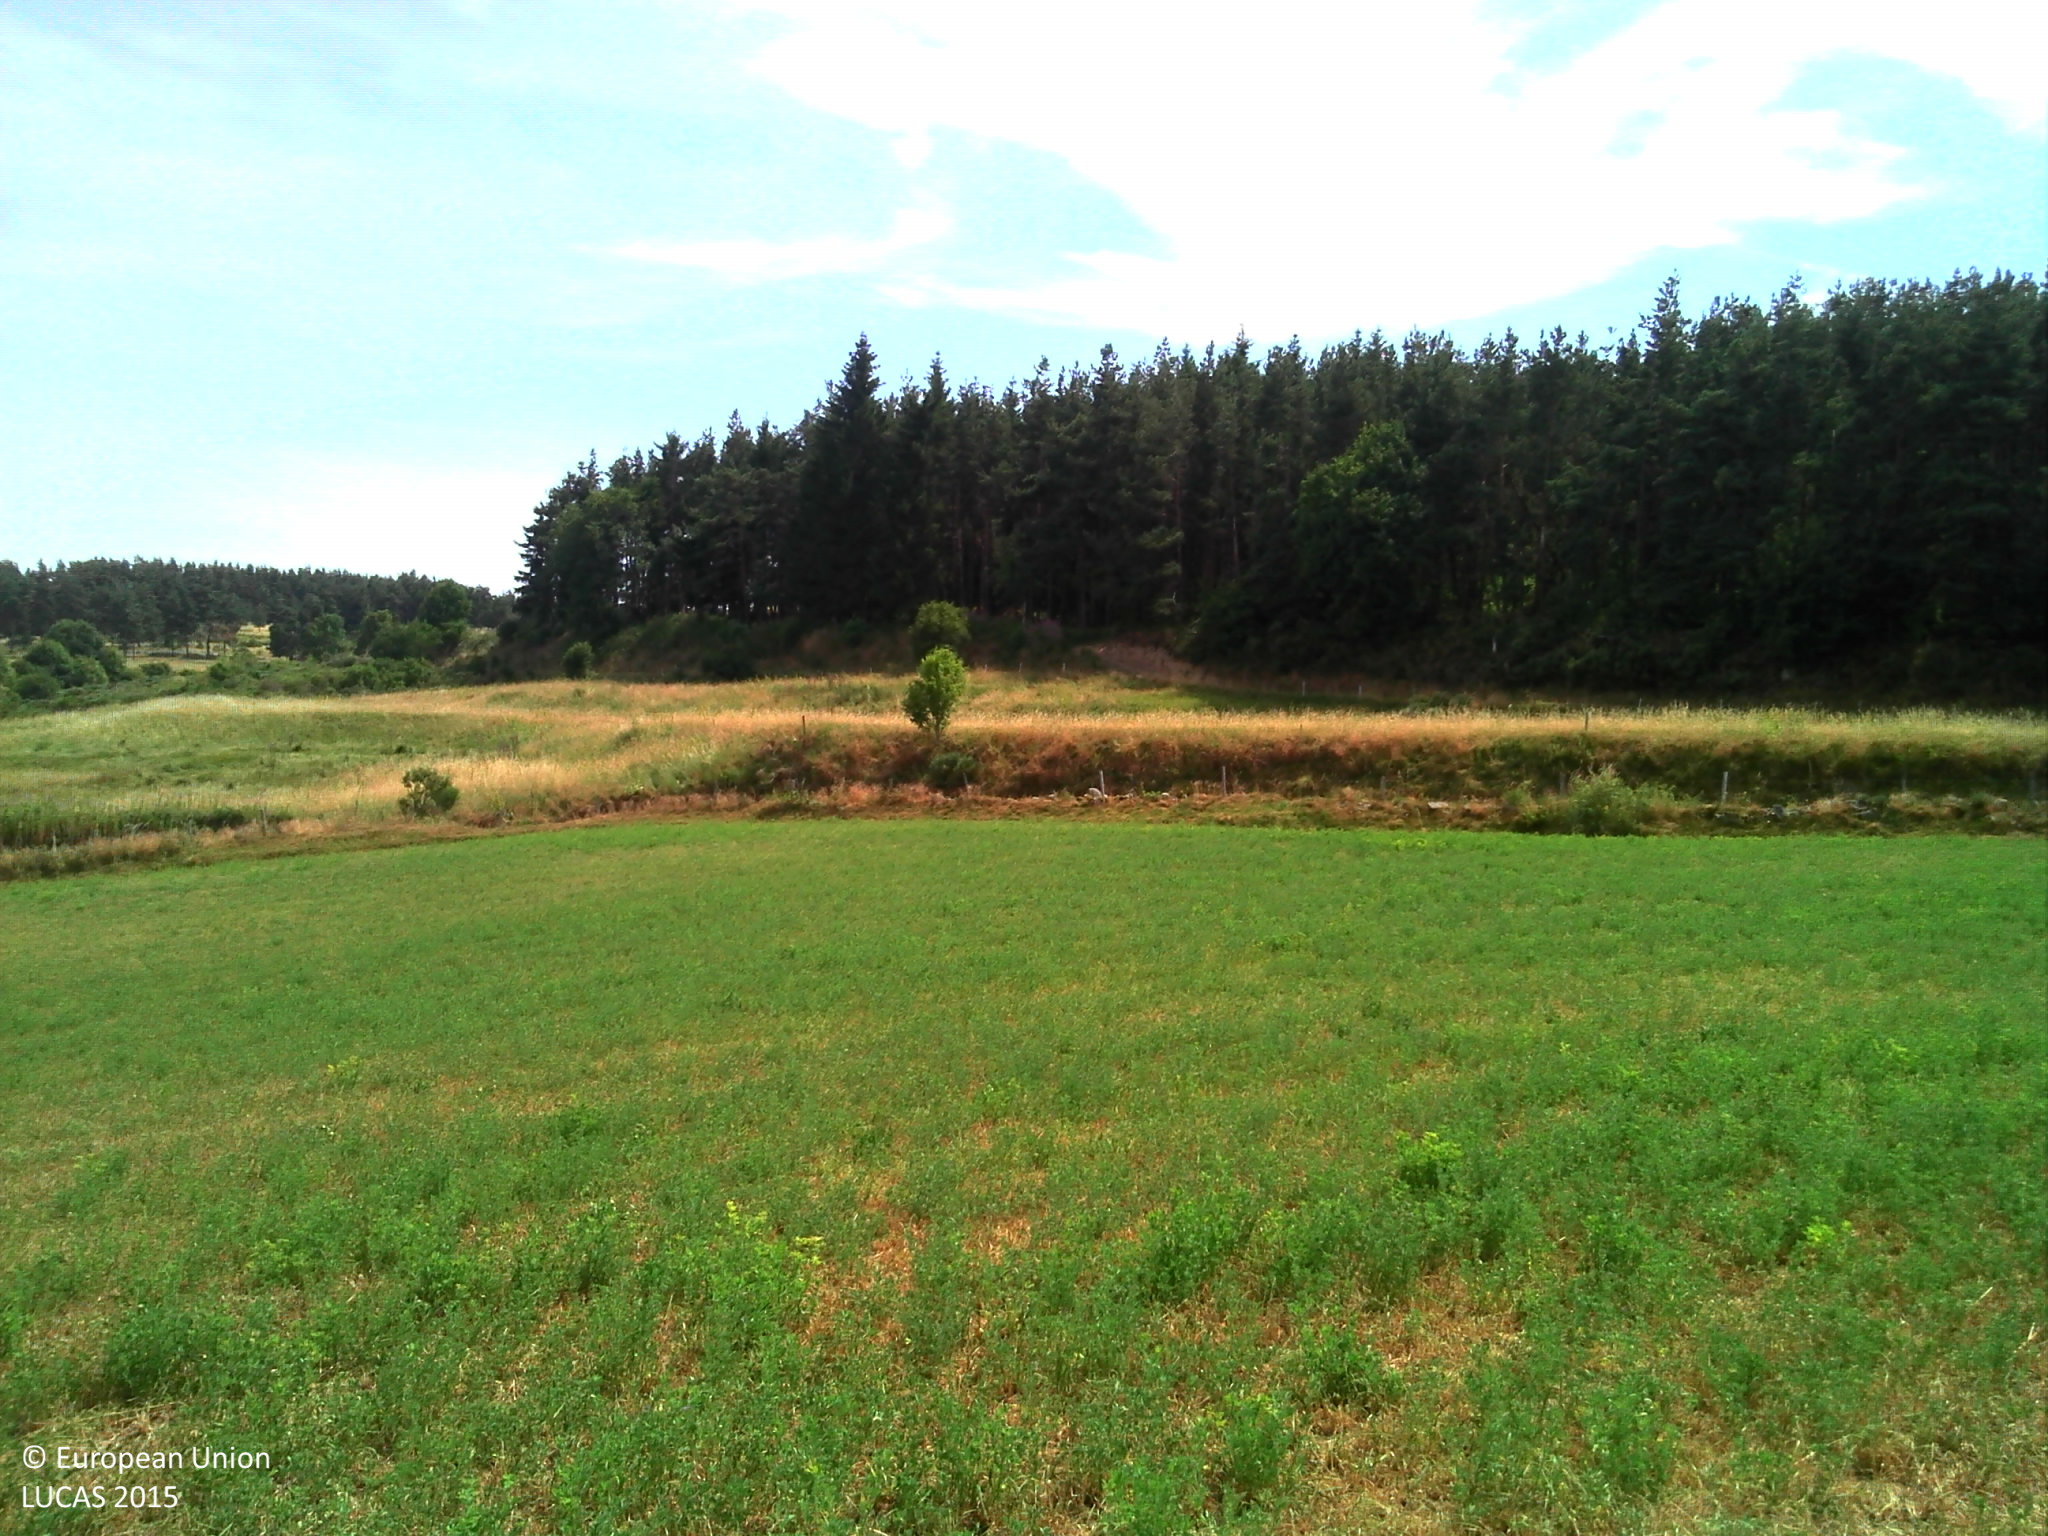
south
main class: Cropland
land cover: Lucerne
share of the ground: > 75 %
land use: Agriculture (excluding fallow land and kitchen gardens)
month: July
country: FR
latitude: 44.9067
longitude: 3.5065
